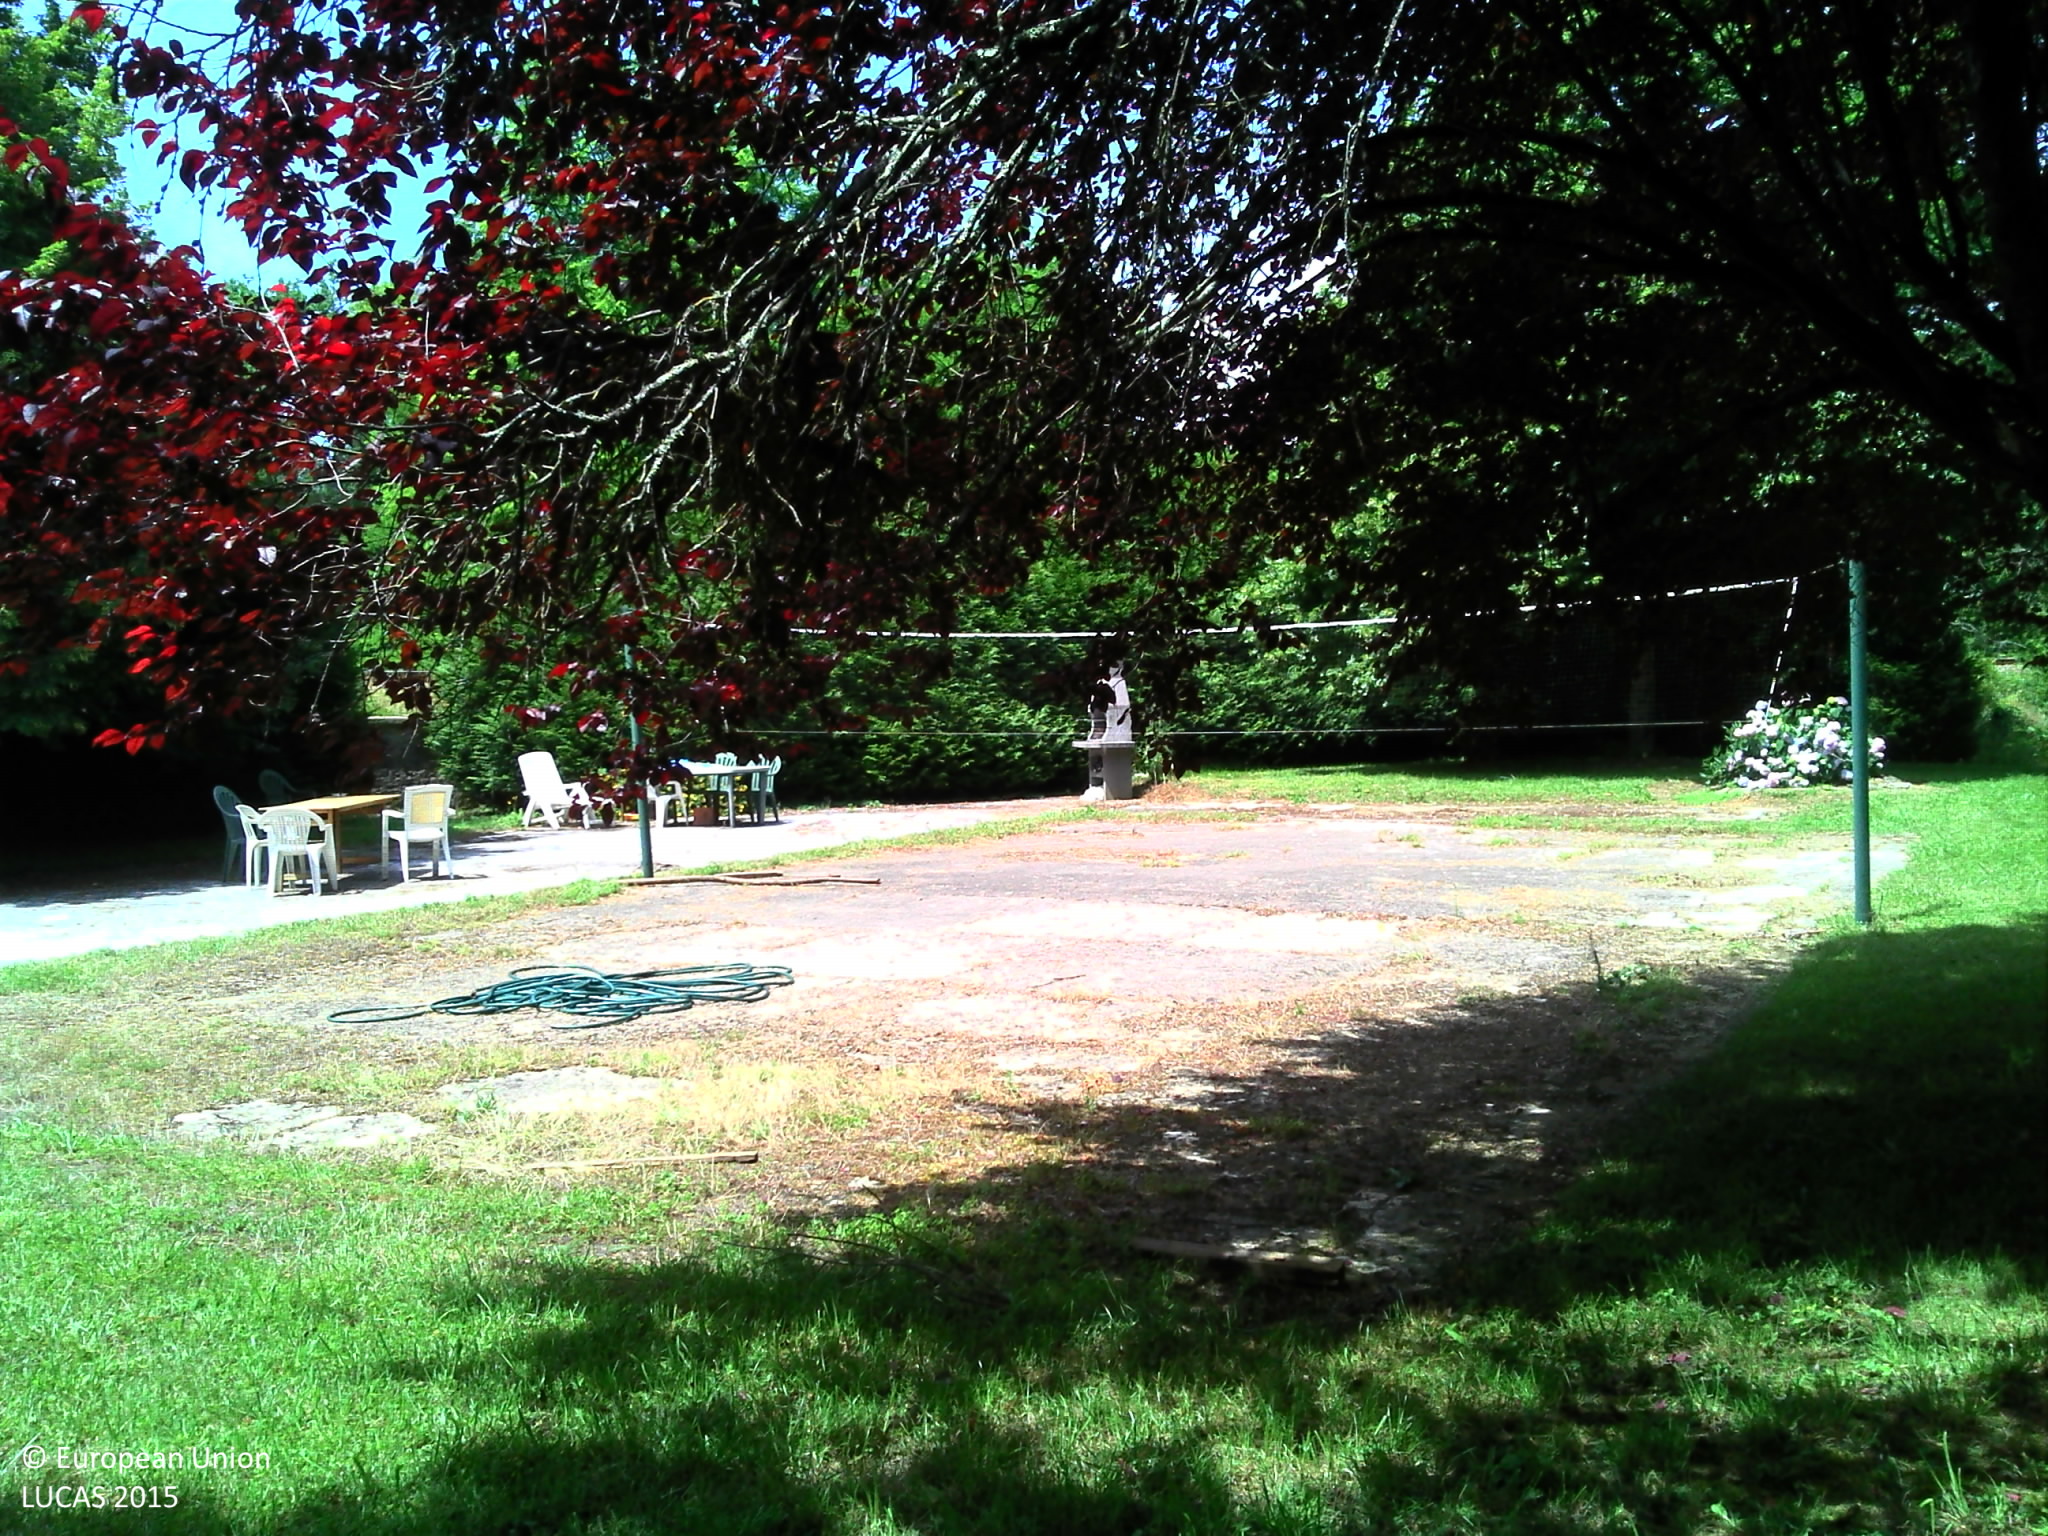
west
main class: Grassland
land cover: Grassland with sparse tree/shrub cover
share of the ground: > 75 %
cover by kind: herbaceous plants 95 %, broadleaved forest trees 5 %
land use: Amenities, museums, leisure
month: June
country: FR
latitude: 45.7738
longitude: 0.4042
